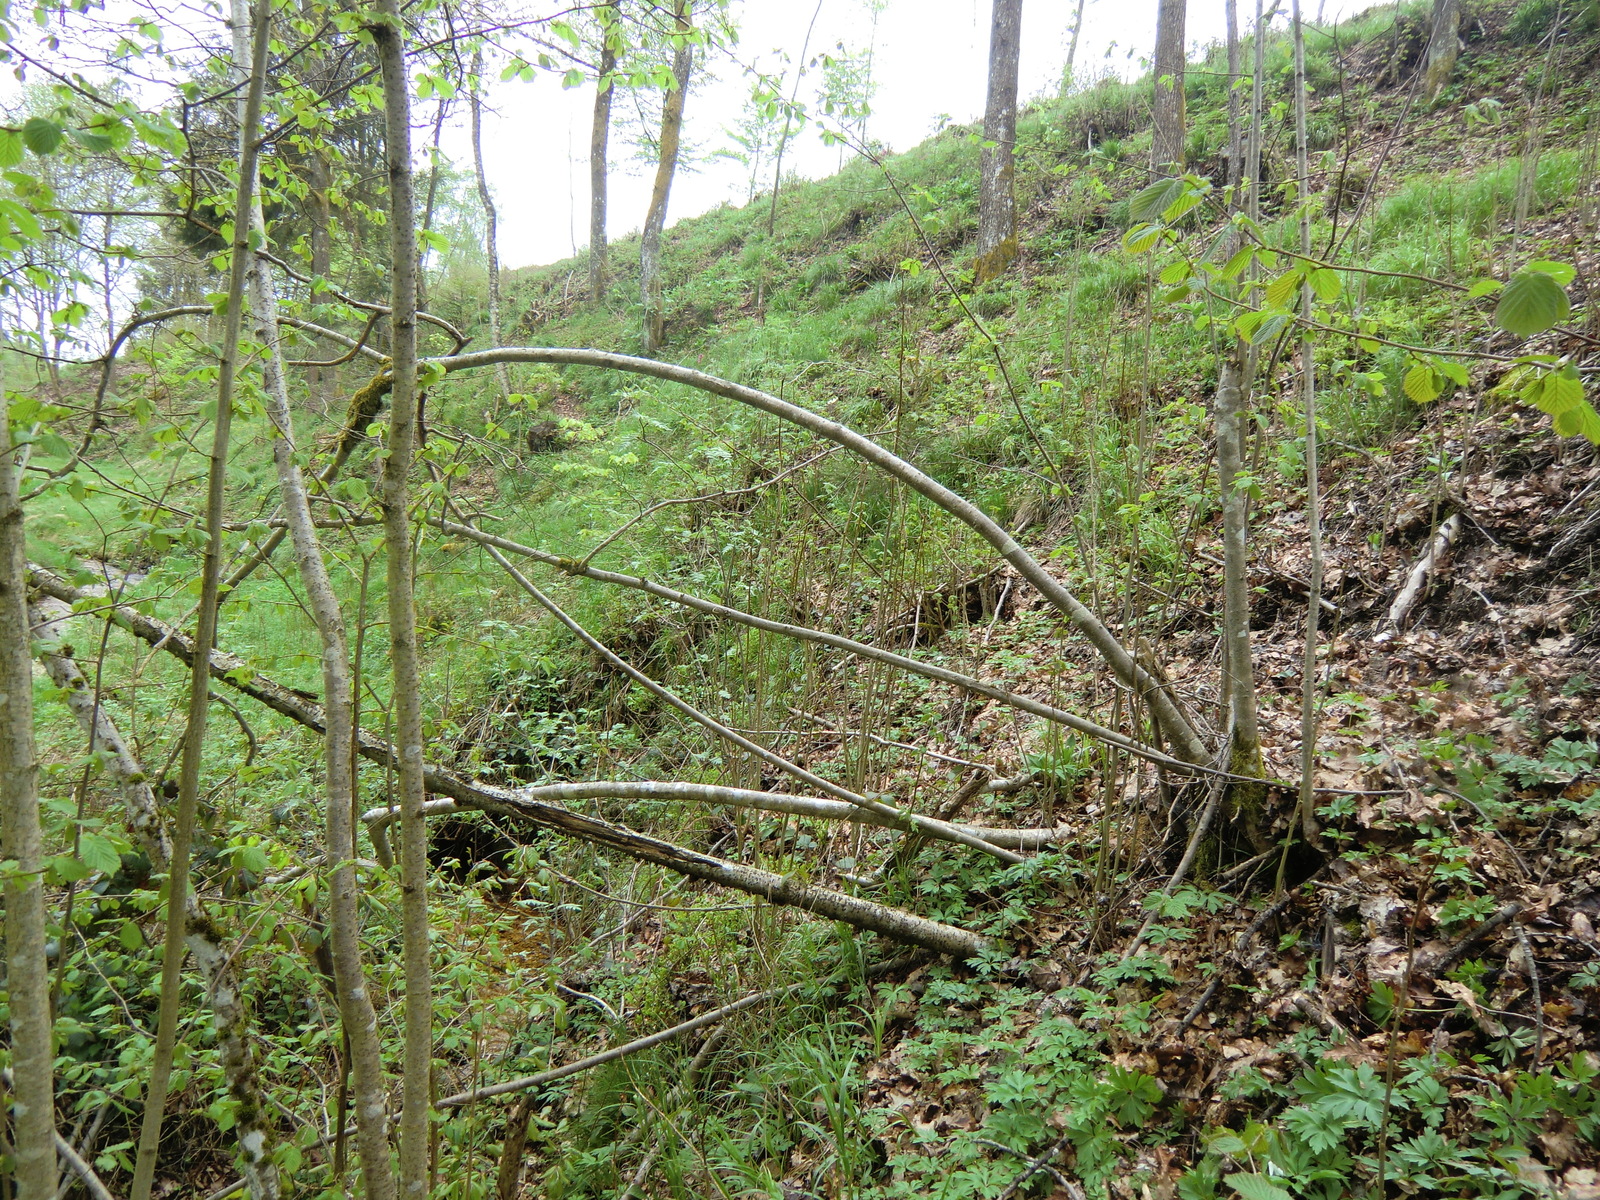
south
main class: Woodland
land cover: Broadleaved woodland
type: floodplain forest
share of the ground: 50 - 75 %
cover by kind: broadleaved forest trees 50 %, herbaceous plants 25 %, shrubs 10 %, unconsolidated bare surface 10 %, coniferous forest trees 5 %
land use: Forestry
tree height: > 5 m
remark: Temporary flooded
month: May
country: AT
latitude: 48.3358
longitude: 14.7900
